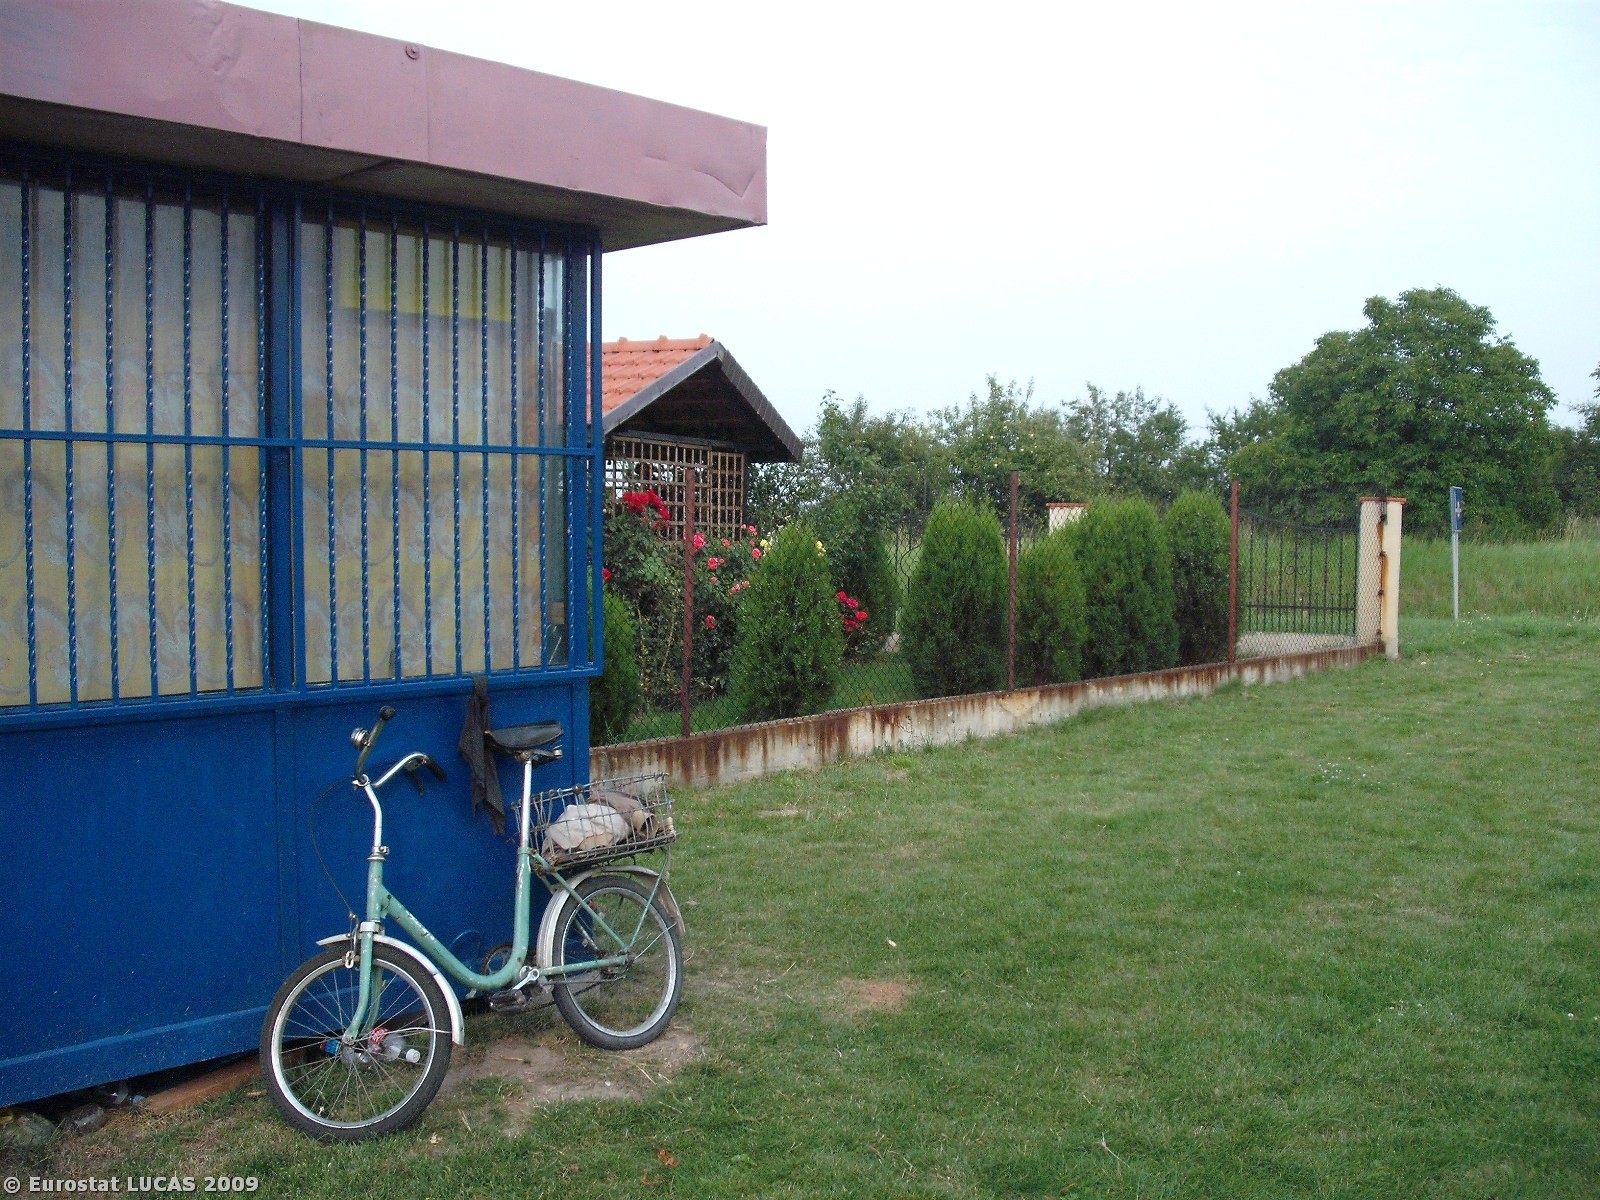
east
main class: Cropland
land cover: Other fresh vegetables
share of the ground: 50 - 75 %
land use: Kitchen garden
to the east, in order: Other fresh vegetables; Artificial constructions in urban areas
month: August
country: PL
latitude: 50.4767
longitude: 20.7076
